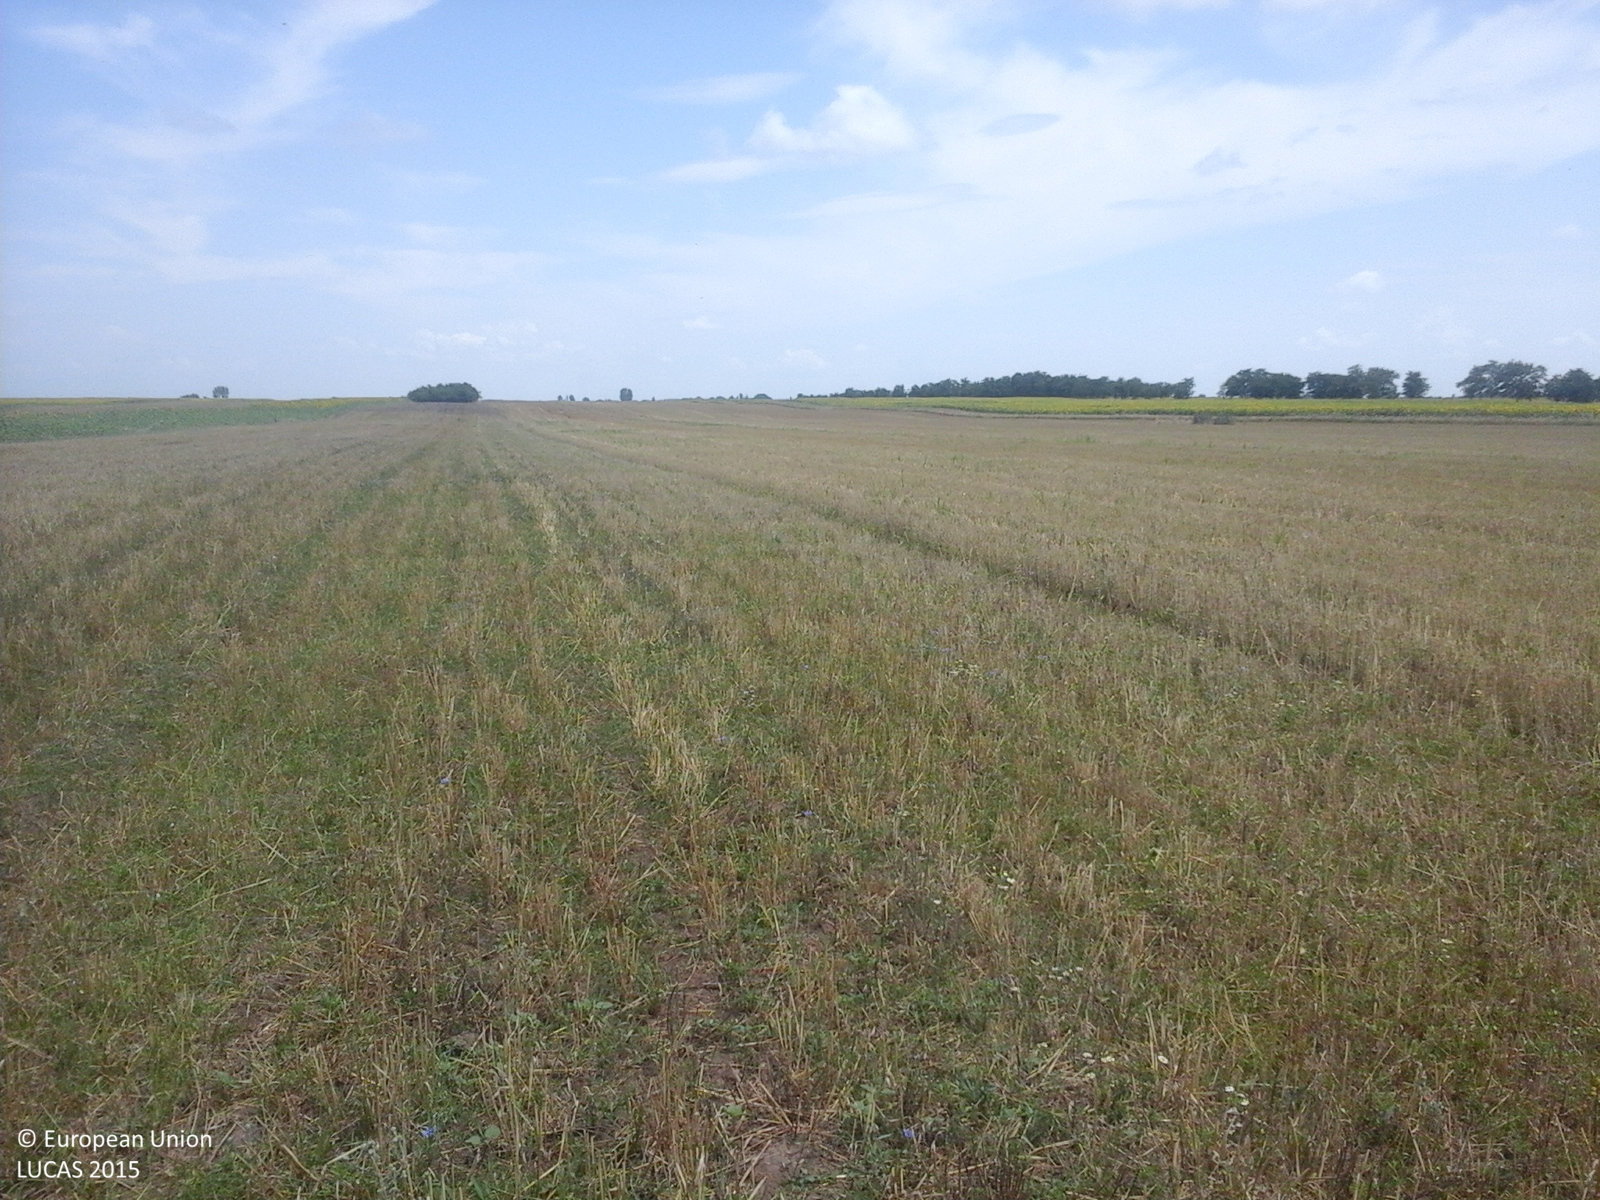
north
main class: Cropland
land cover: Common wheat
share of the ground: > 75 %
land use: Agriculture (excluding fallow land and kitchen gardens)
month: July
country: RO
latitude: 43.9319
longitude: 24.2240
